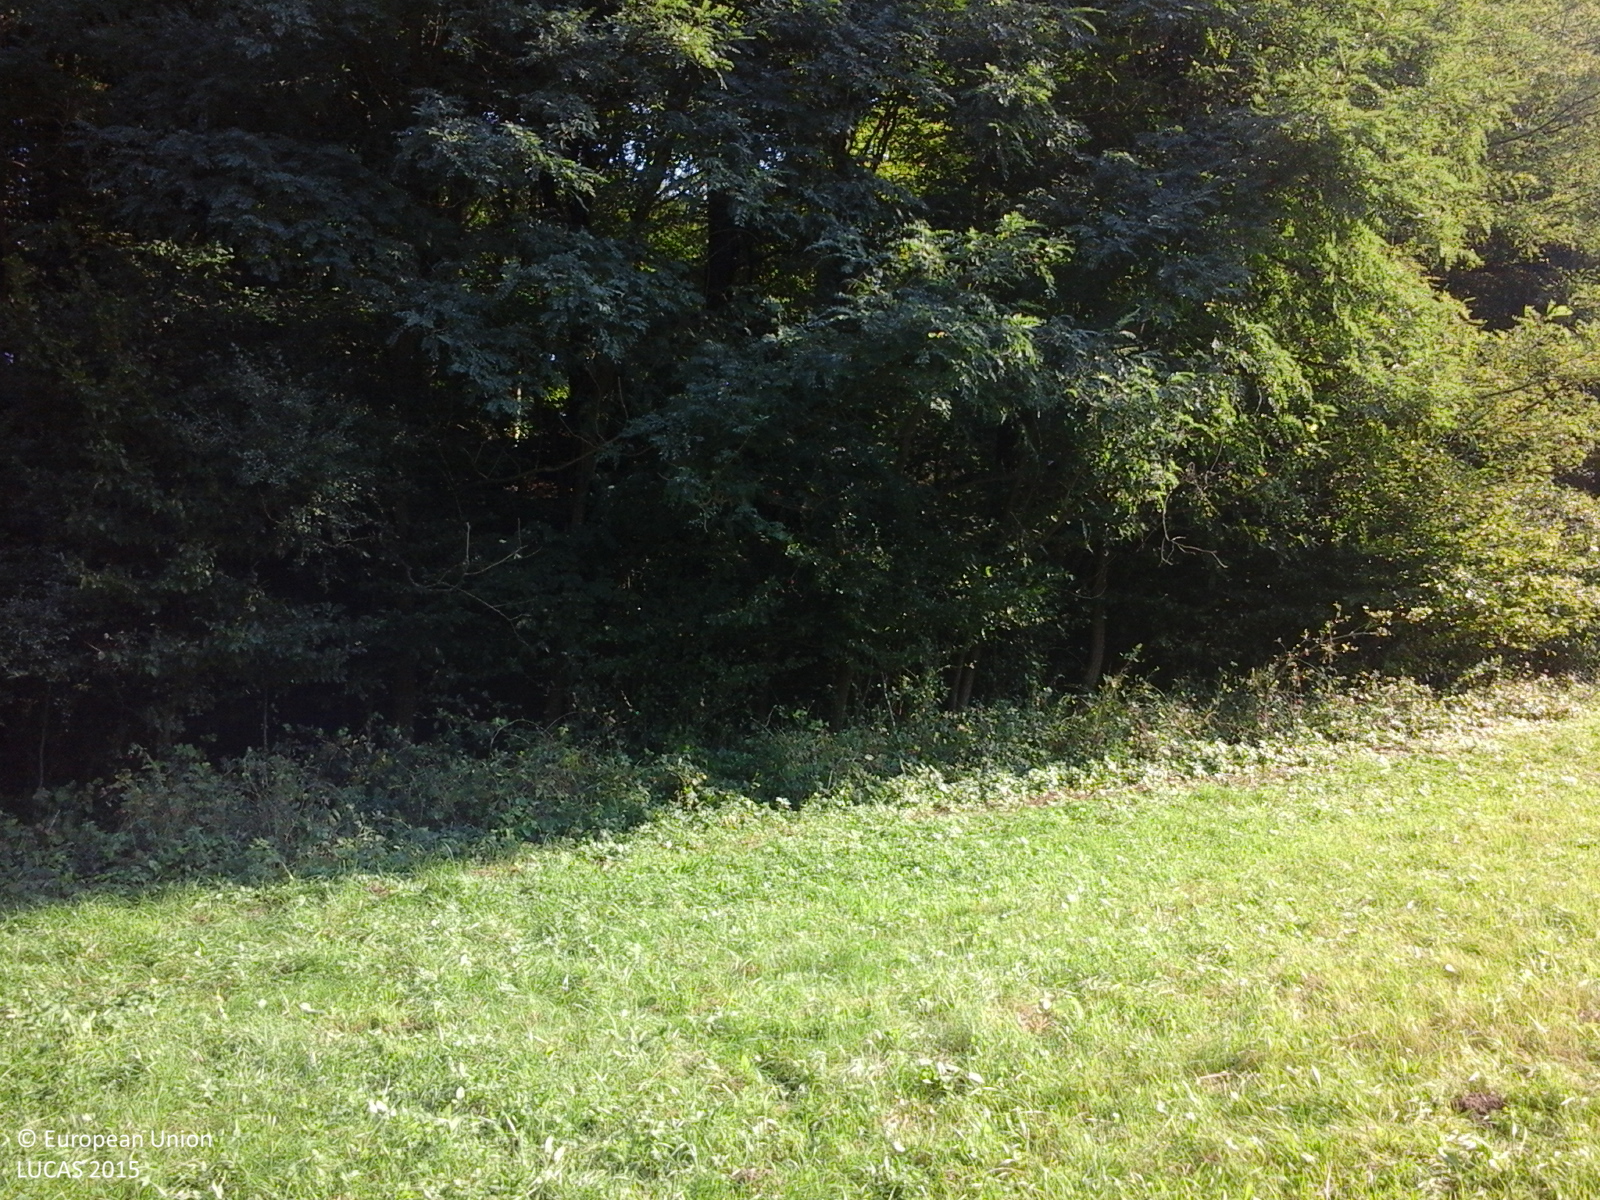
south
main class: Grassland
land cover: Grassland without tree/shrub cover
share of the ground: > 75 %
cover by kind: herbaceous plants 100 %
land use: Agriculture (excluding fallow land and kitchen gardens)
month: September
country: RO
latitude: 47.2629
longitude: 22.7335
